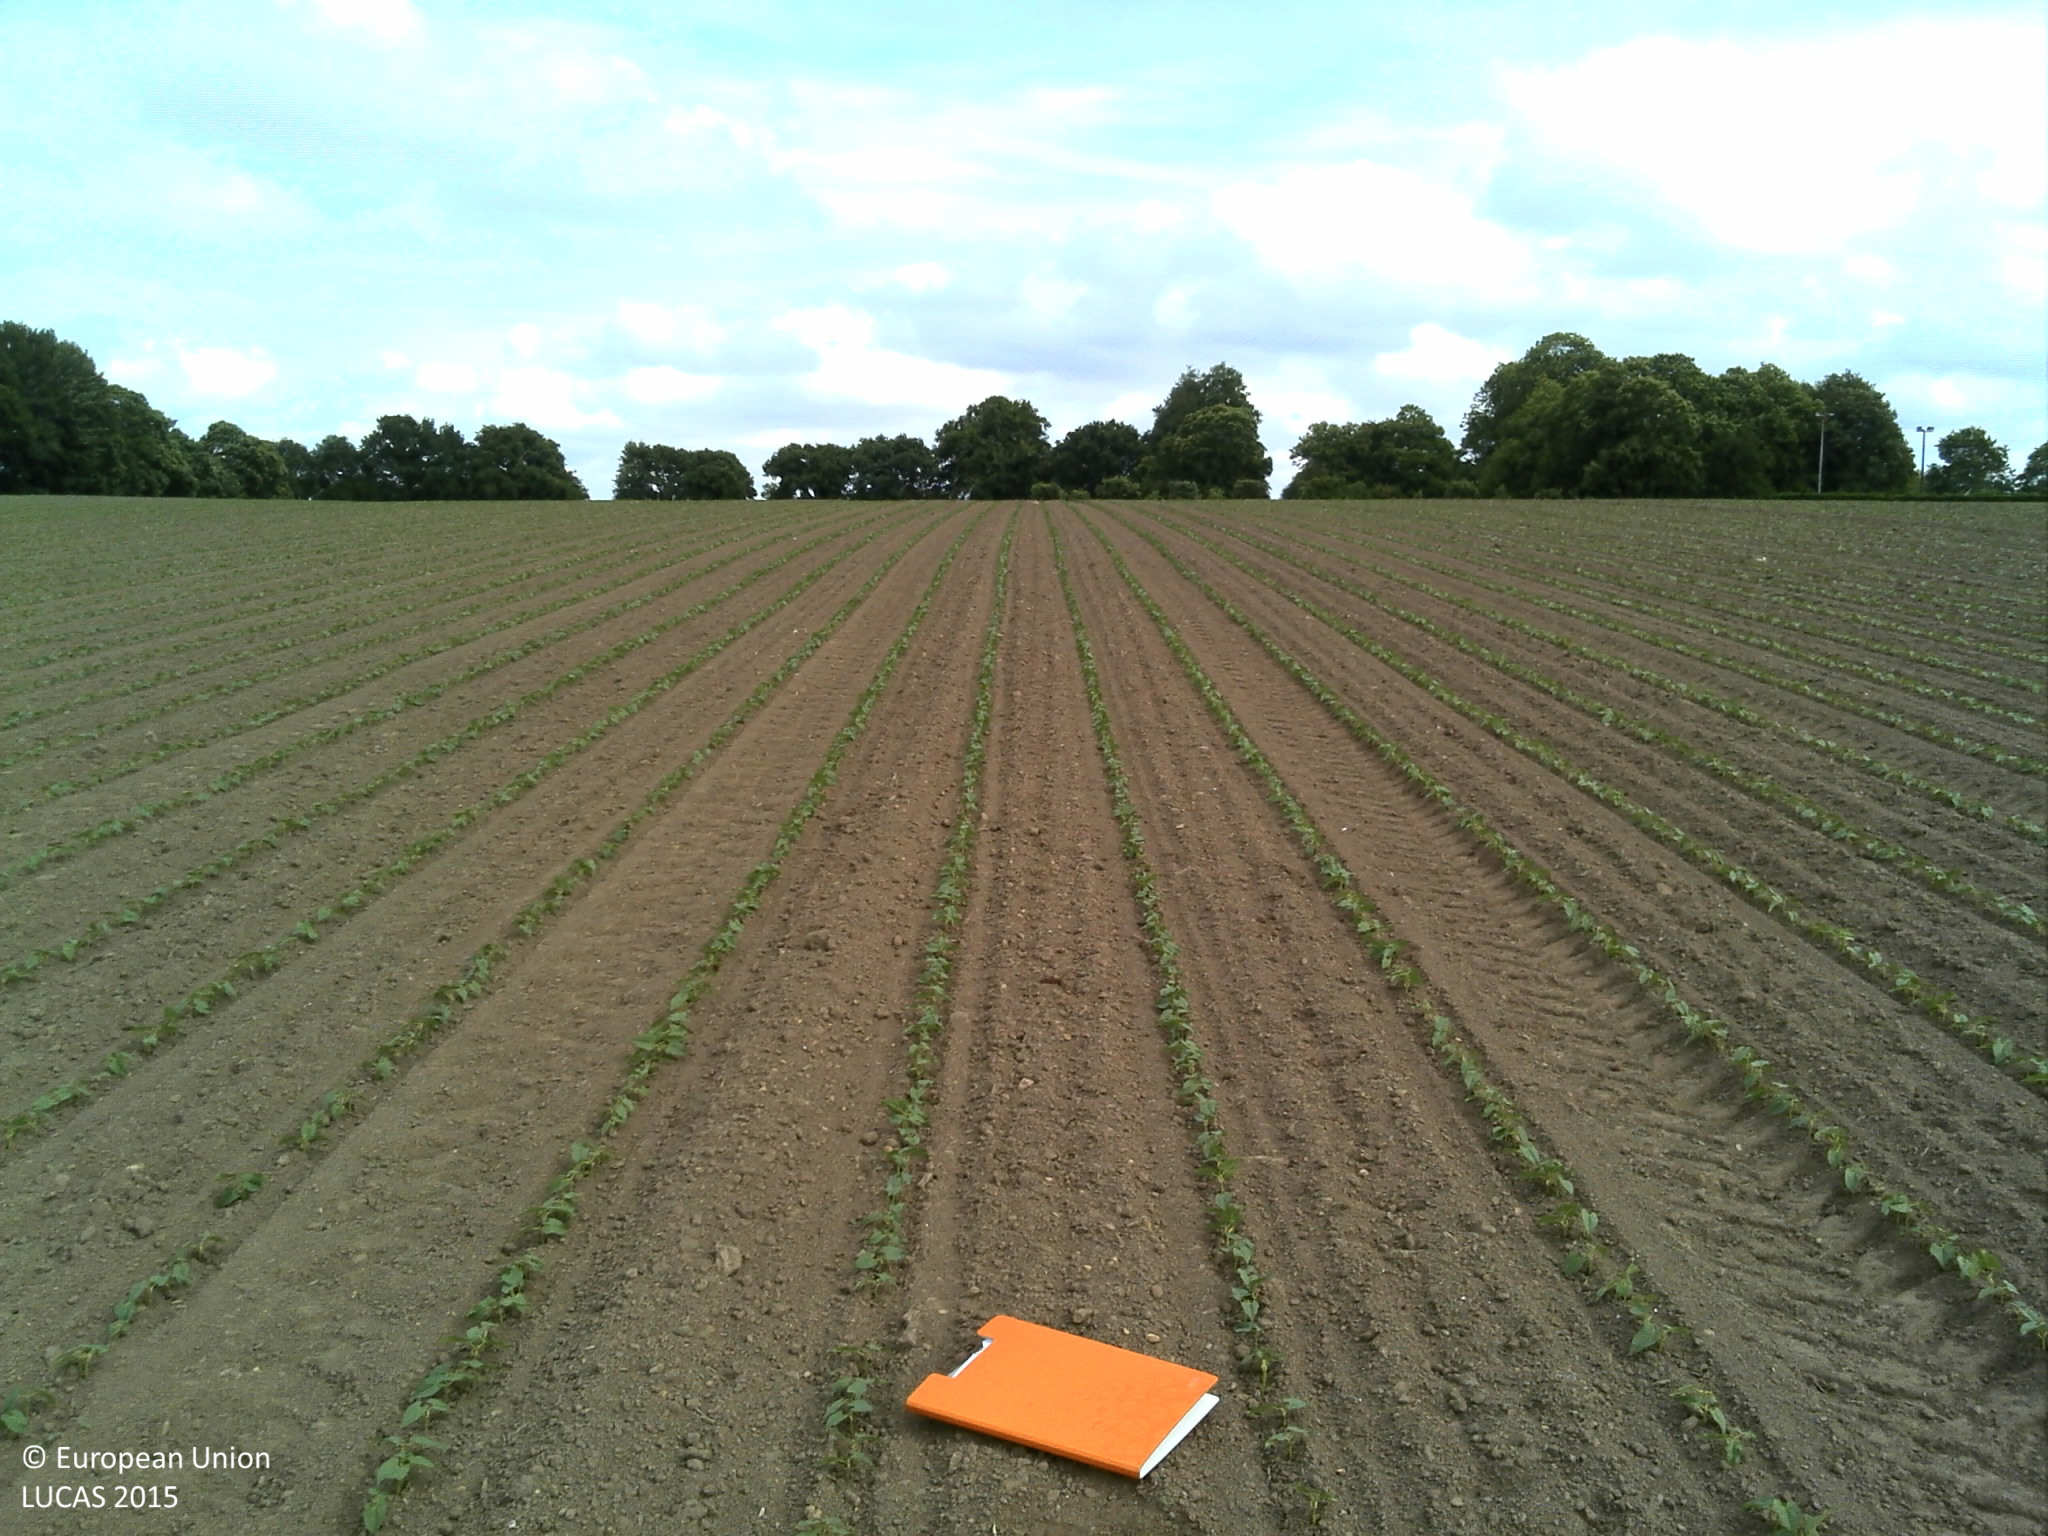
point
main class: Cropland
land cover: Other fresh vegetables
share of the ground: < 10 %
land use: Agriculture (excluding fallow land and kitchen gardens)
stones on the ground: 10 - 25 %
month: June
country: FR
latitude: 47.9079
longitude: -3.5768
